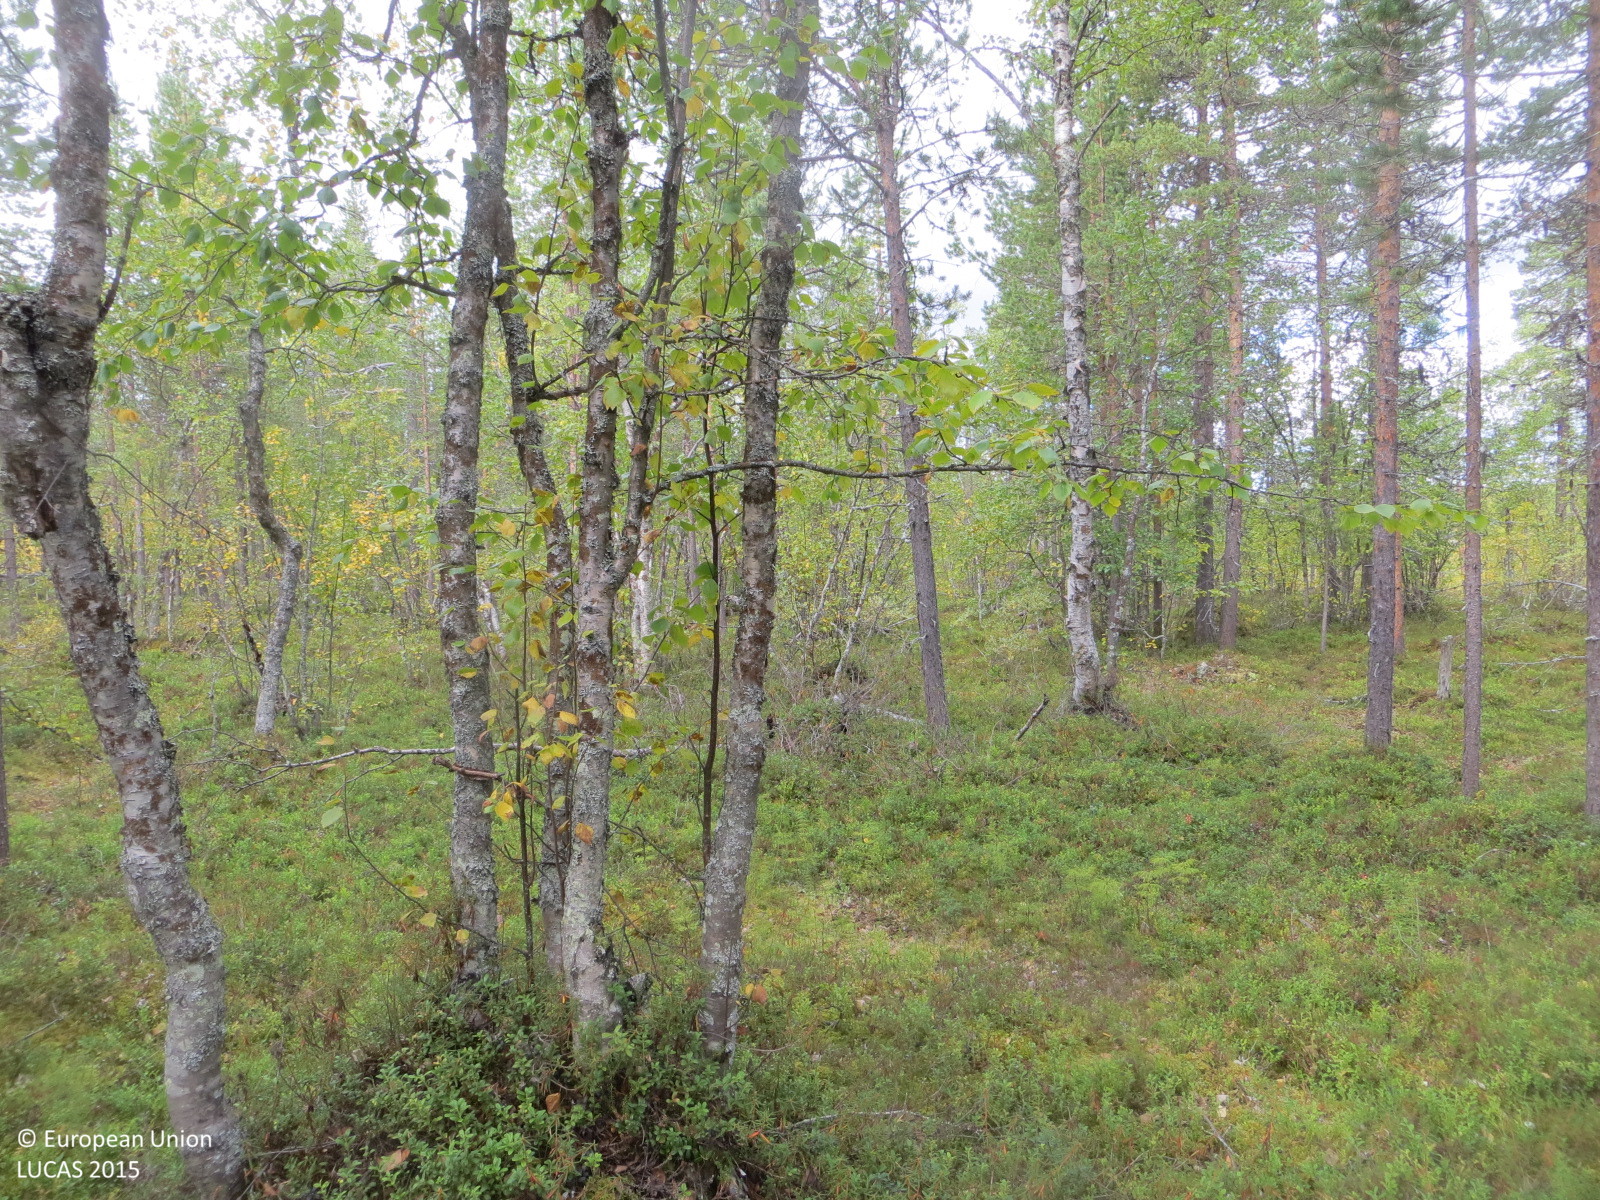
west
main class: Woodland
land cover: Pine dominated mixed woodland
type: boreal forest
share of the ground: 50 - 75 %
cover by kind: shrubs 50 %, coniferous forest trees 35 %, broadleaved forest trees 15 %
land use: Forestry
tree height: > 5 m
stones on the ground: < 10 %
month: September
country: FI
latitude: 68.3580
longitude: 24.1288
